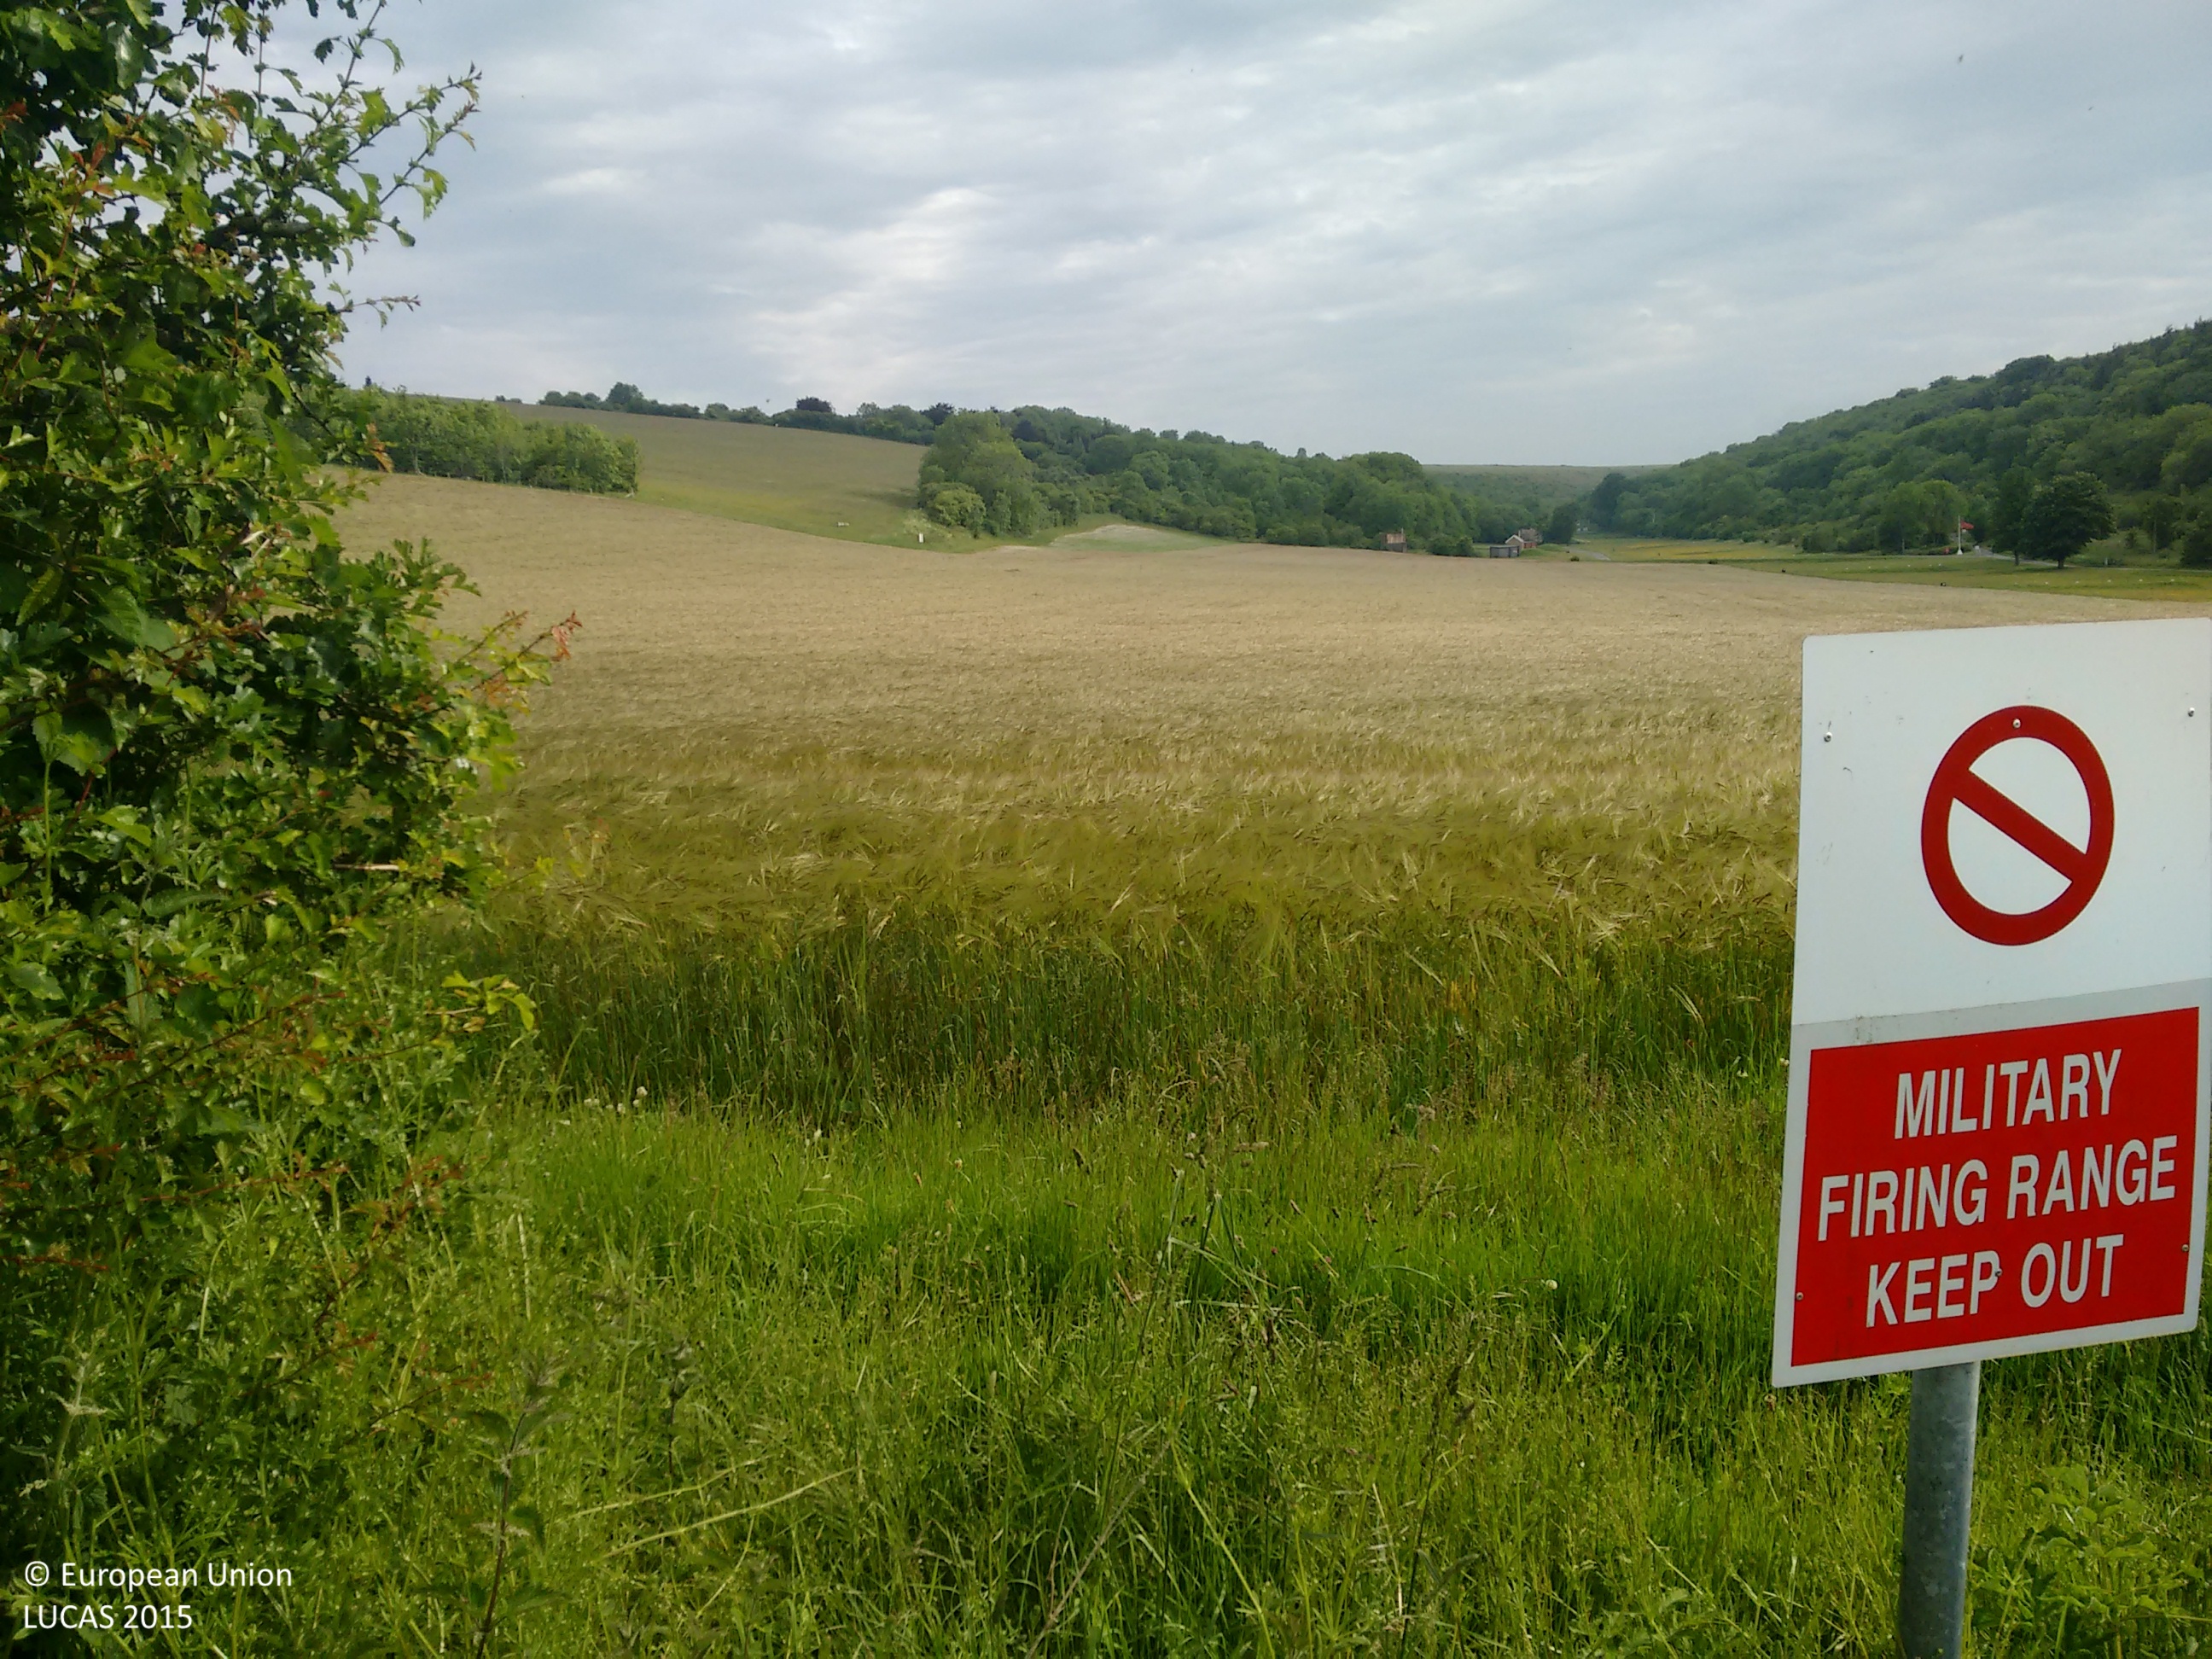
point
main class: Cropland
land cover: Barley
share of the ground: > 75 %
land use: Agriculture (excluding fallow land and kitchen gardens)
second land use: Community services
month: June
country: GB
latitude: 51.2220
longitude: -2.1599
